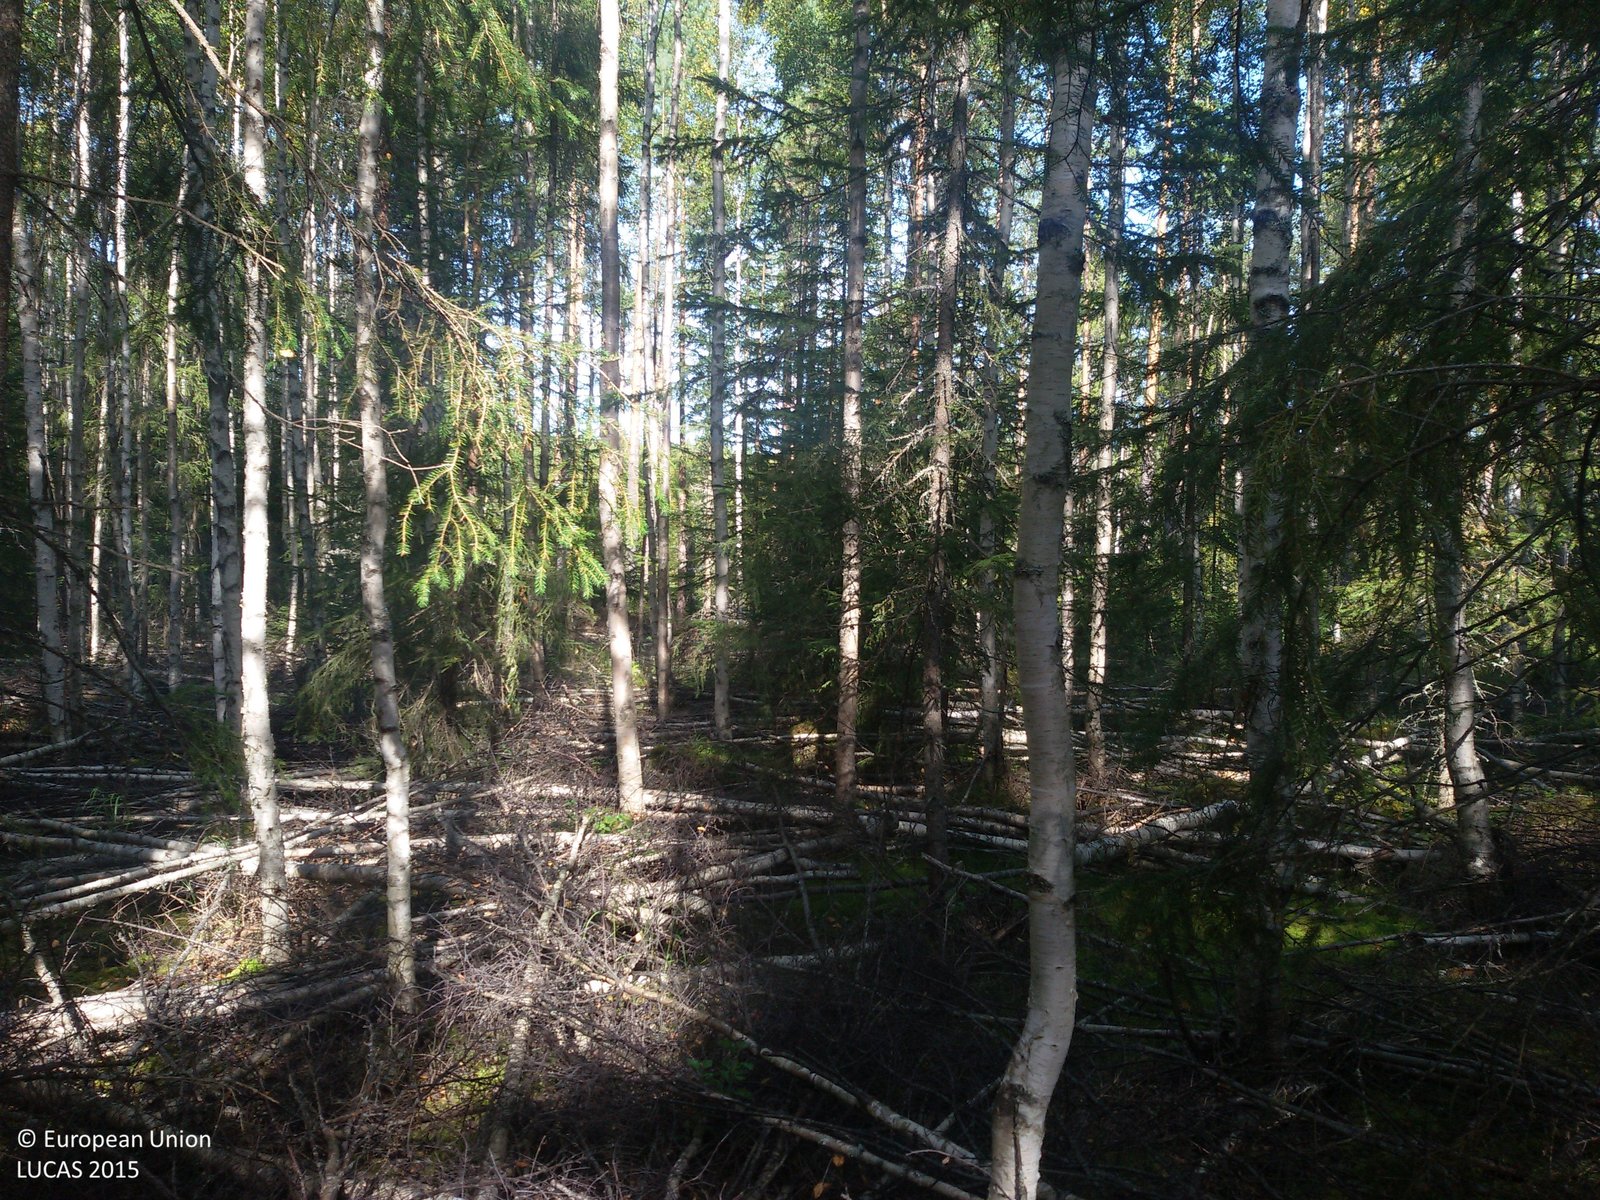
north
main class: Woodland
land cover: Spruce dominated mixed woodland
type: boreal forest
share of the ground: > 75 %
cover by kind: coniferous forest trees 50 %, broadleaved forest trees 30 %, lichens and mosses 10 %
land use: Forestry
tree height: > 5 m
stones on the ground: > 50 %
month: September
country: SE
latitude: 60.9598
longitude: 14.9541
